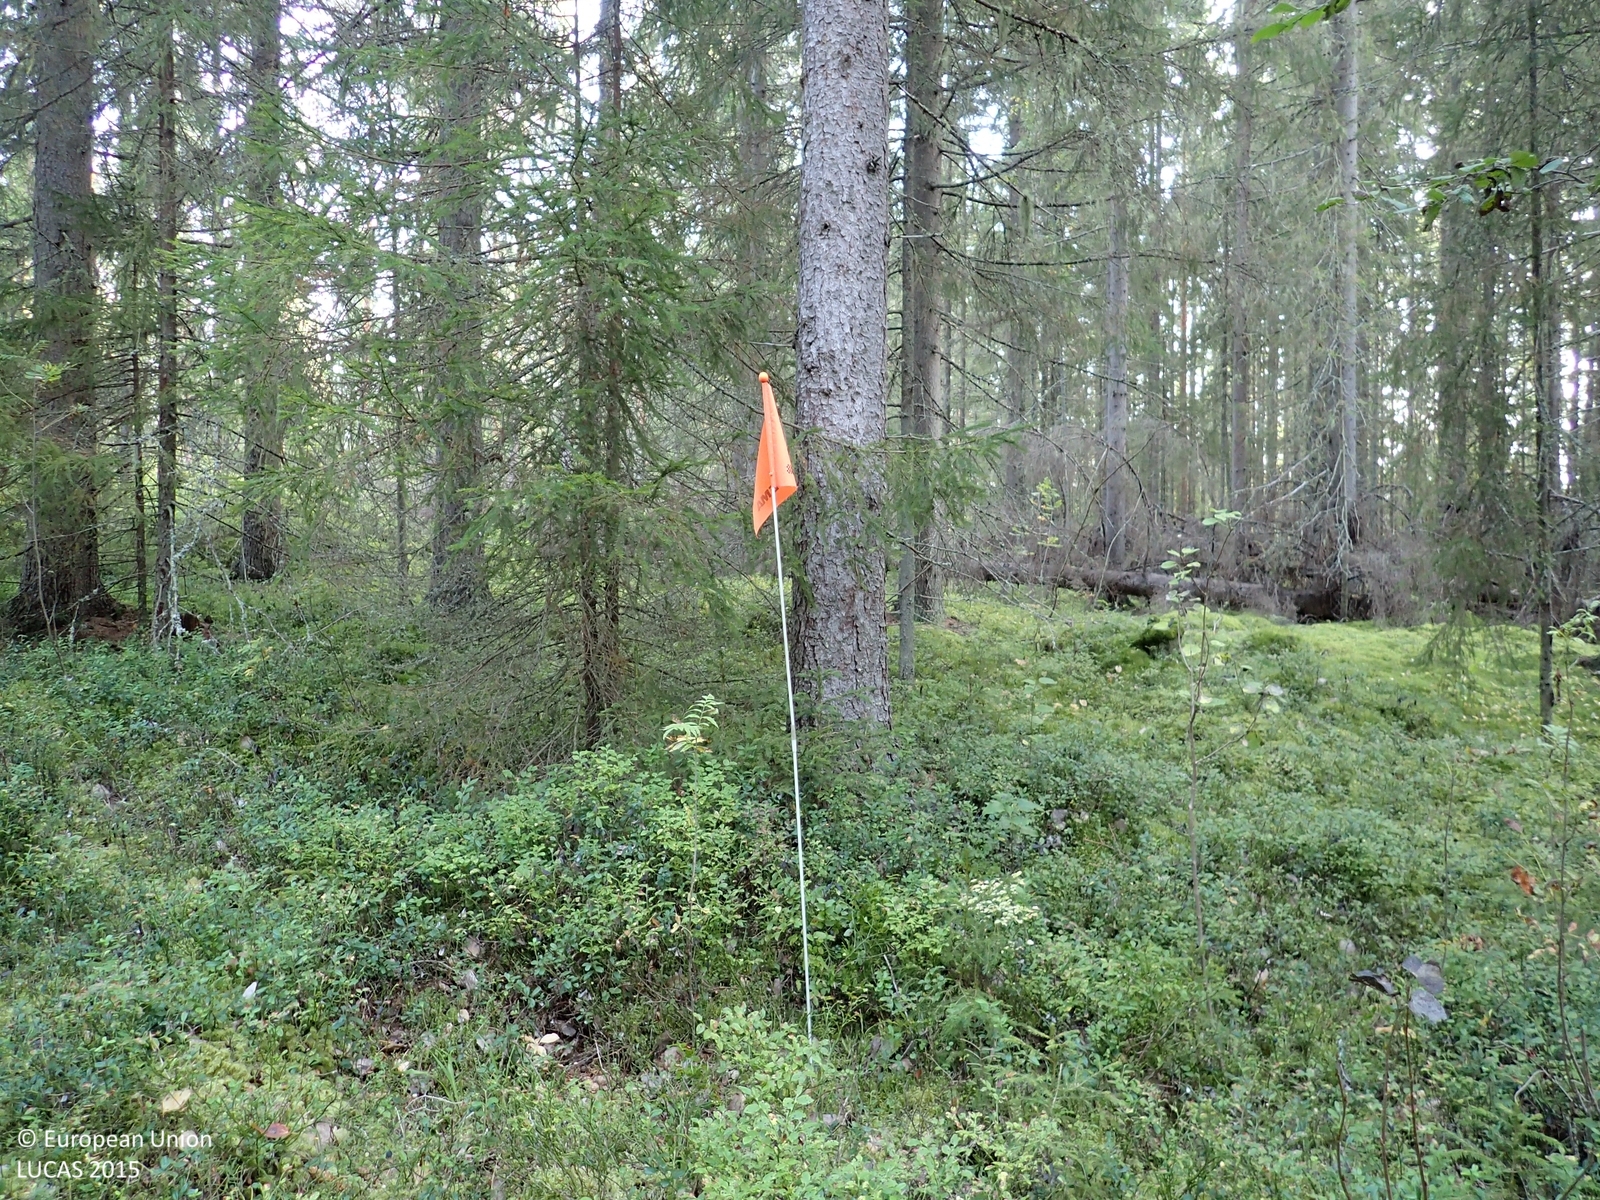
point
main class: Woodland
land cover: Spruce dominated coniferous woodland
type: boreal forest
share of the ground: > 75 %
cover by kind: coniferous forest trees 75 %, shrubs 15 %, broadleaved forest trees 5 %, lichens and mosses 5 %
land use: Forestry
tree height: > 5 m
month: September
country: FI
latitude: 63.0746
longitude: 25.6884
